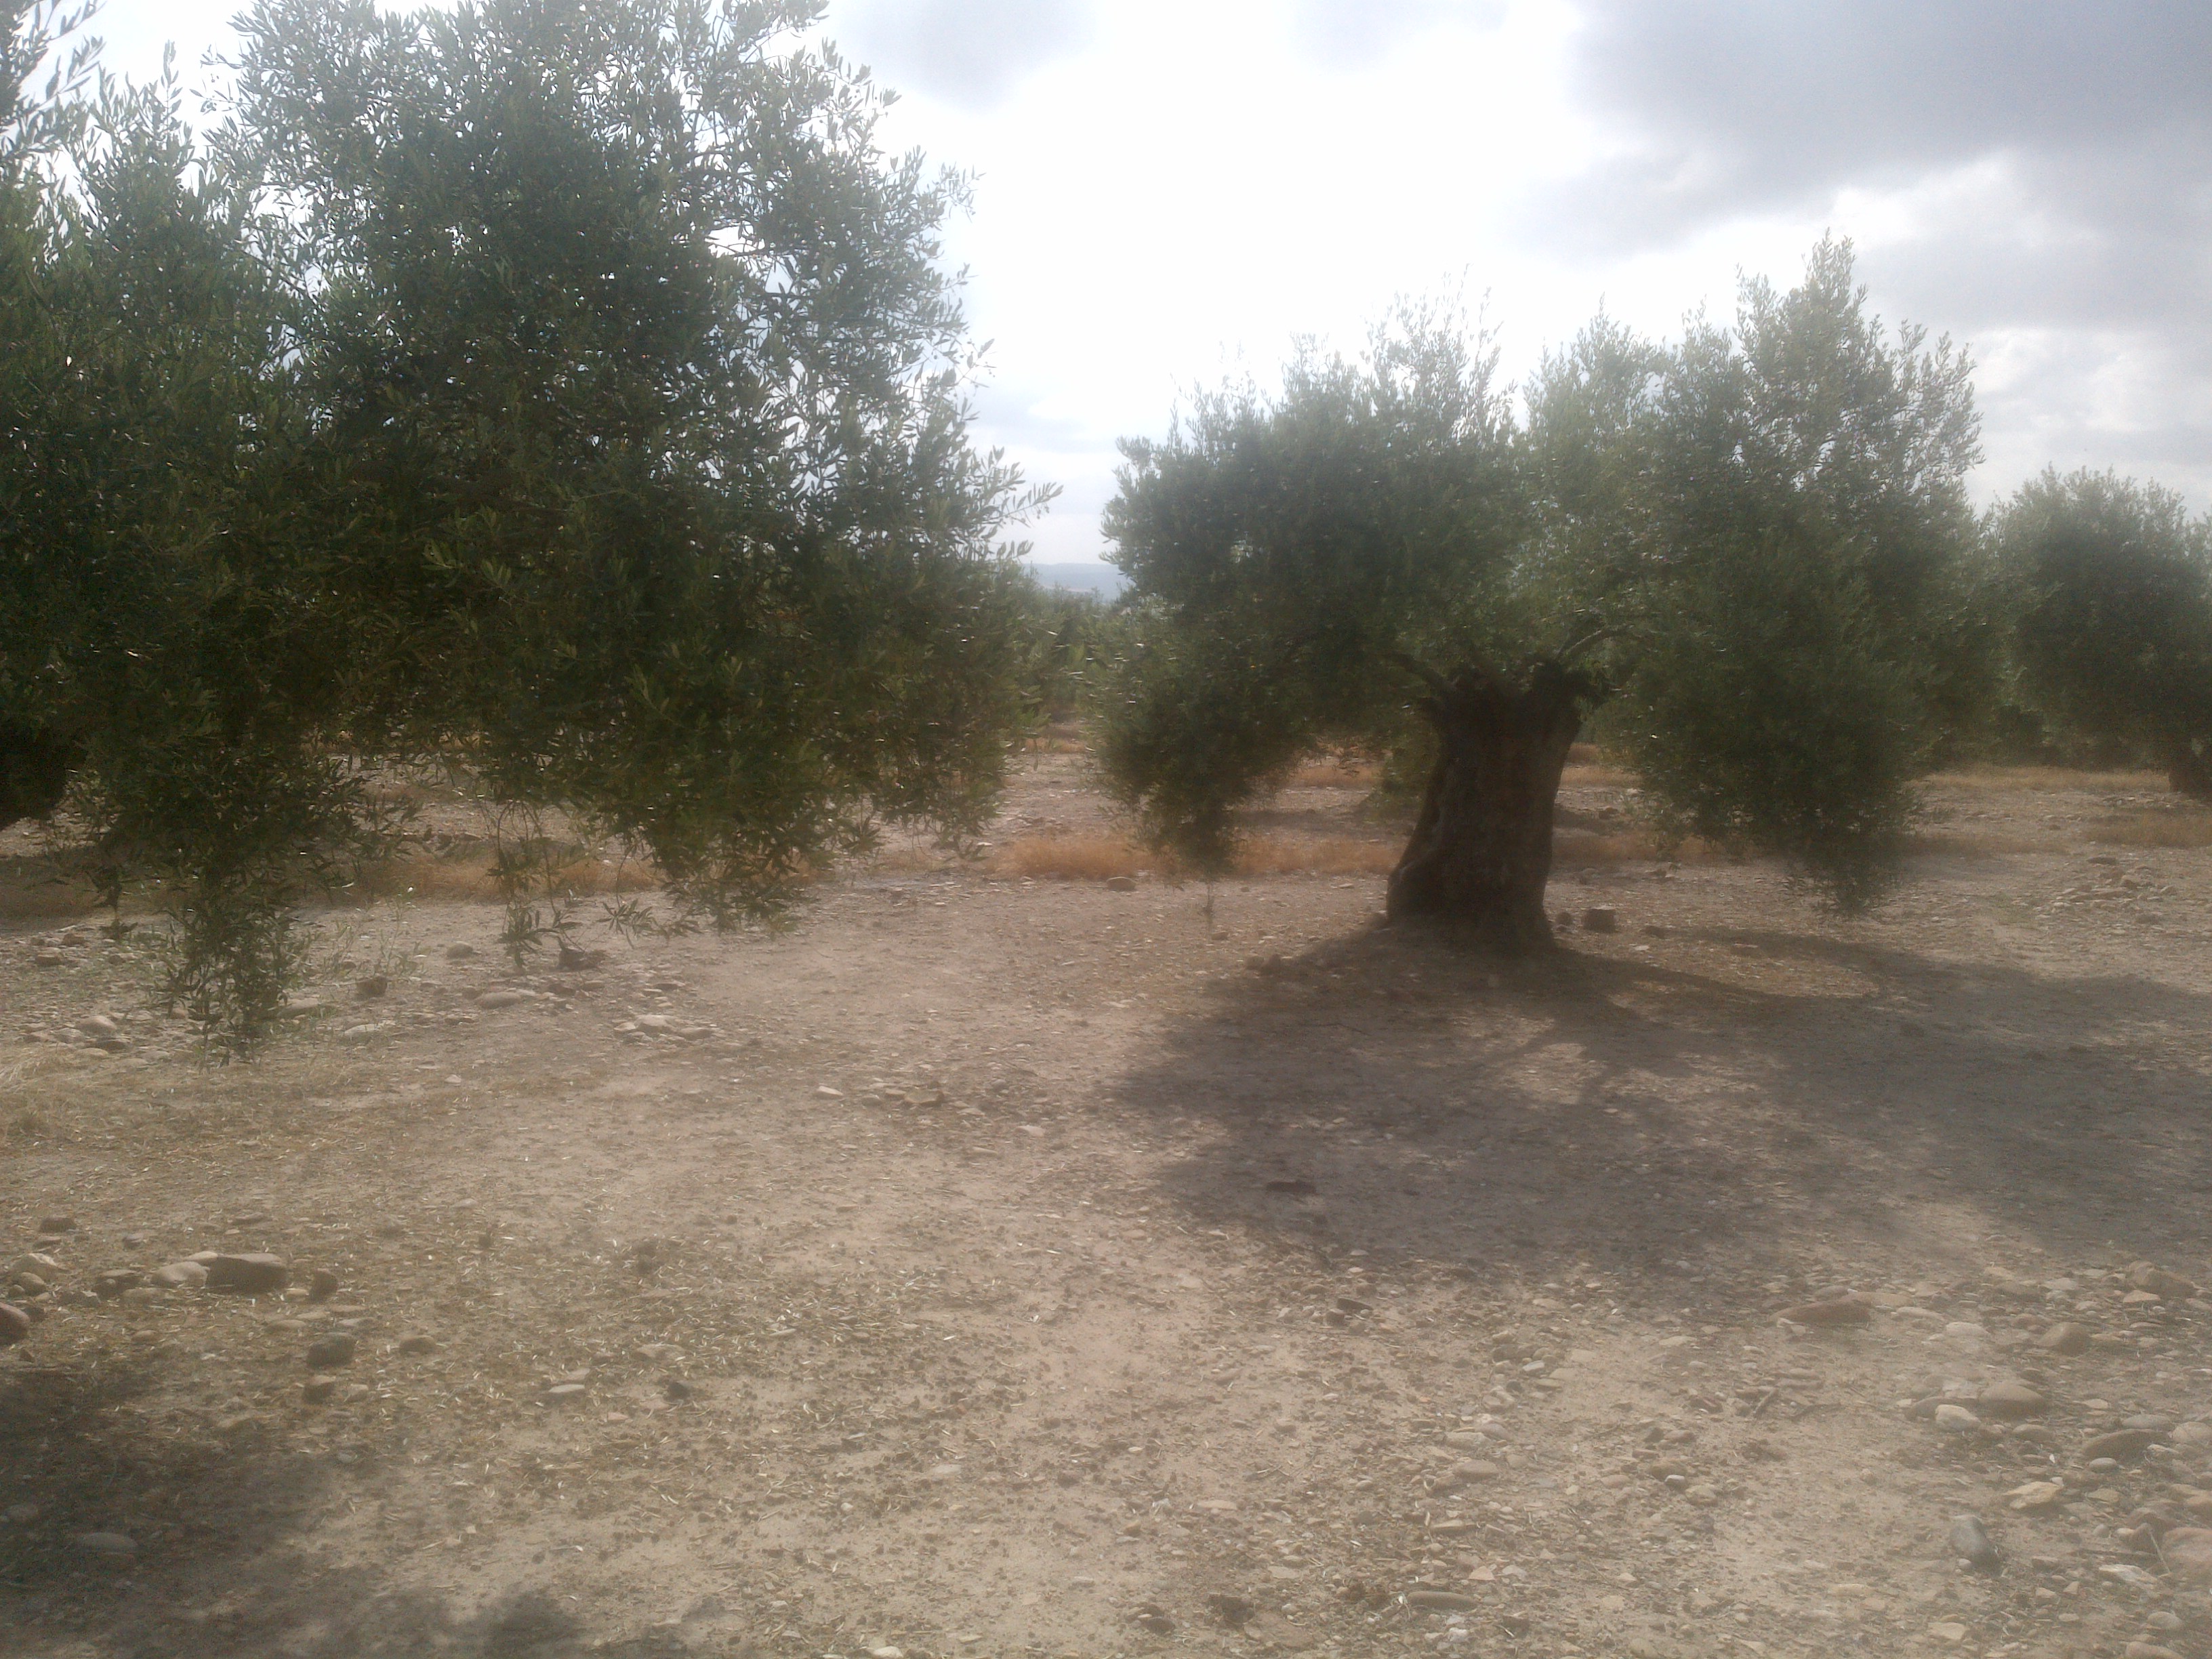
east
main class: Cropland
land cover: Olive groves
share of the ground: 25 - 50 %
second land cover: Spontaneously vegetated surfaces
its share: 10 - 25 %
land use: Agriculture (excluding fallow land and kitchen gardens)
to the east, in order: Olive groves; Spontaneously vegetated surfaces; Fences; Olive groves; Other bare soil; Olive groves; Fences; Olive groves; Grass margins; Ditches and canals; Tracks; Grass margins; Ditches and canals; Olive groves
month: June
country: ES
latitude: 37.9323
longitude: -4.5180
